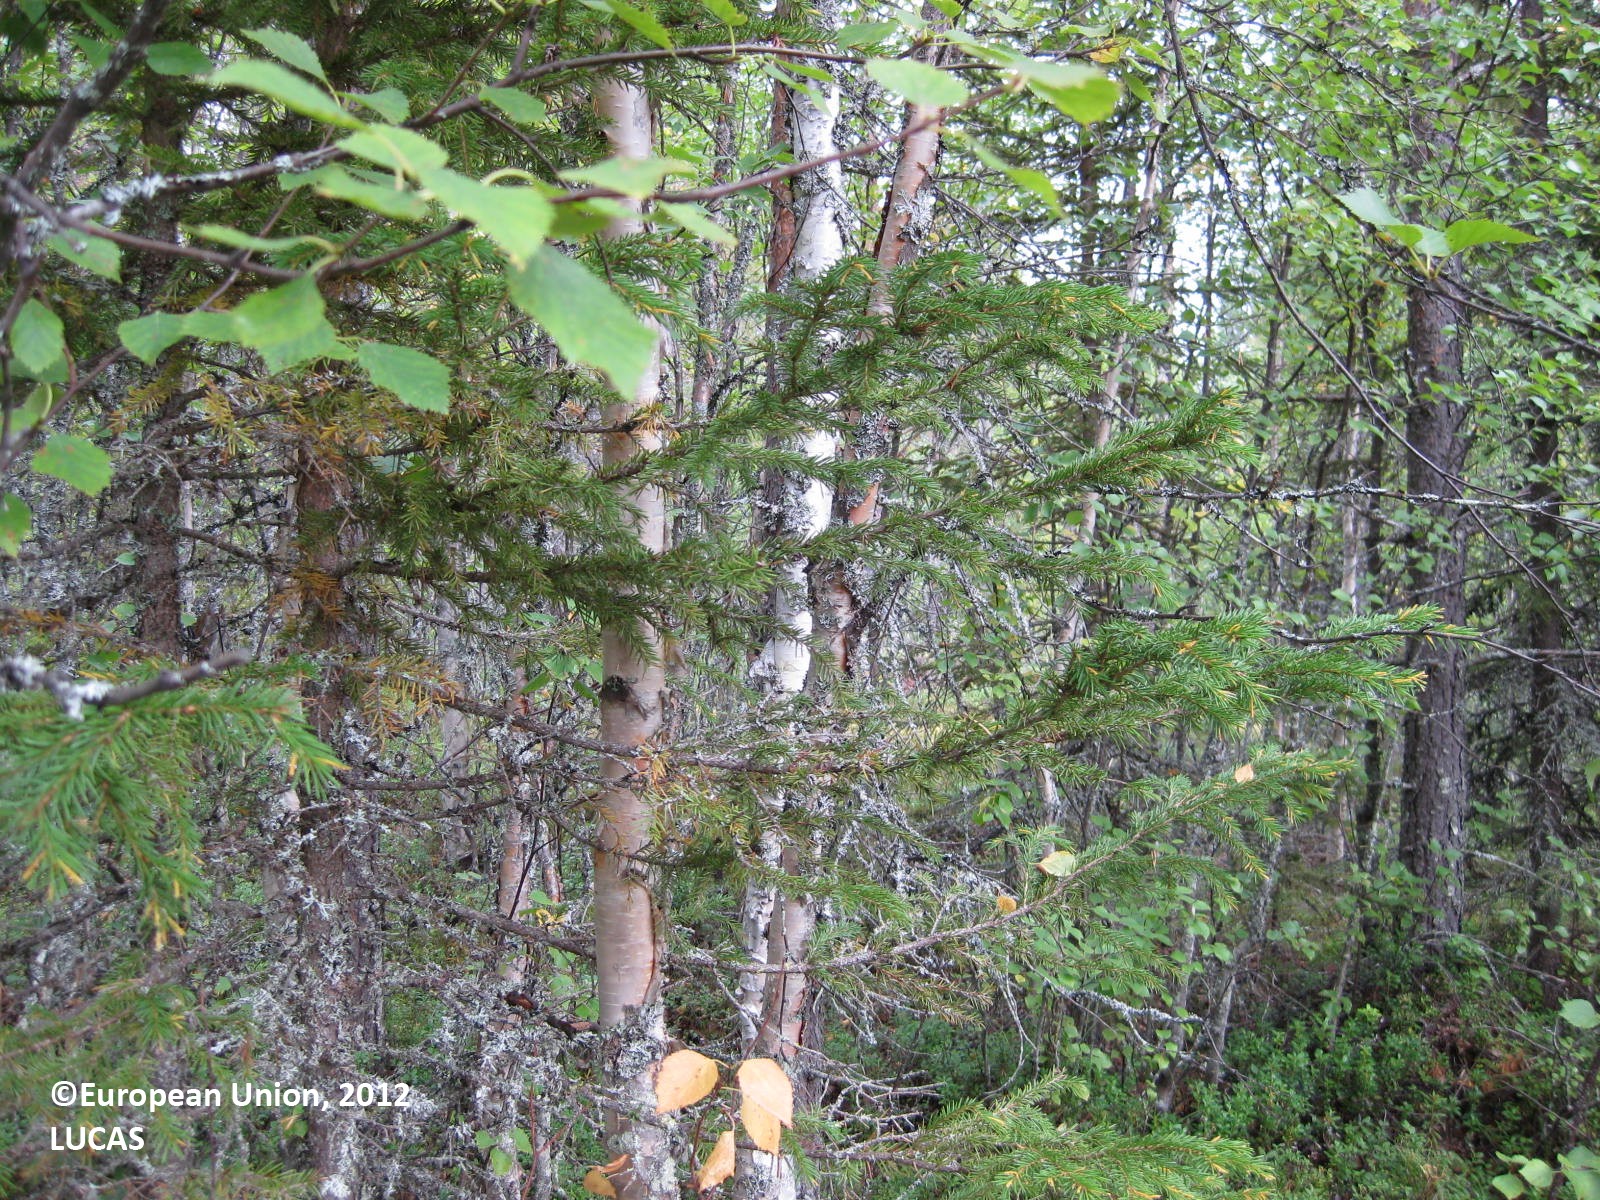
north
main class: Woodland
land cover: Pine dominated mixed woodland
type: boreal forest
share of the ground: > 75 %
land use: Forestry
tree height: > 5 m
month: August
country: FI
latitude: 66.2542
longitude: 28.7871
